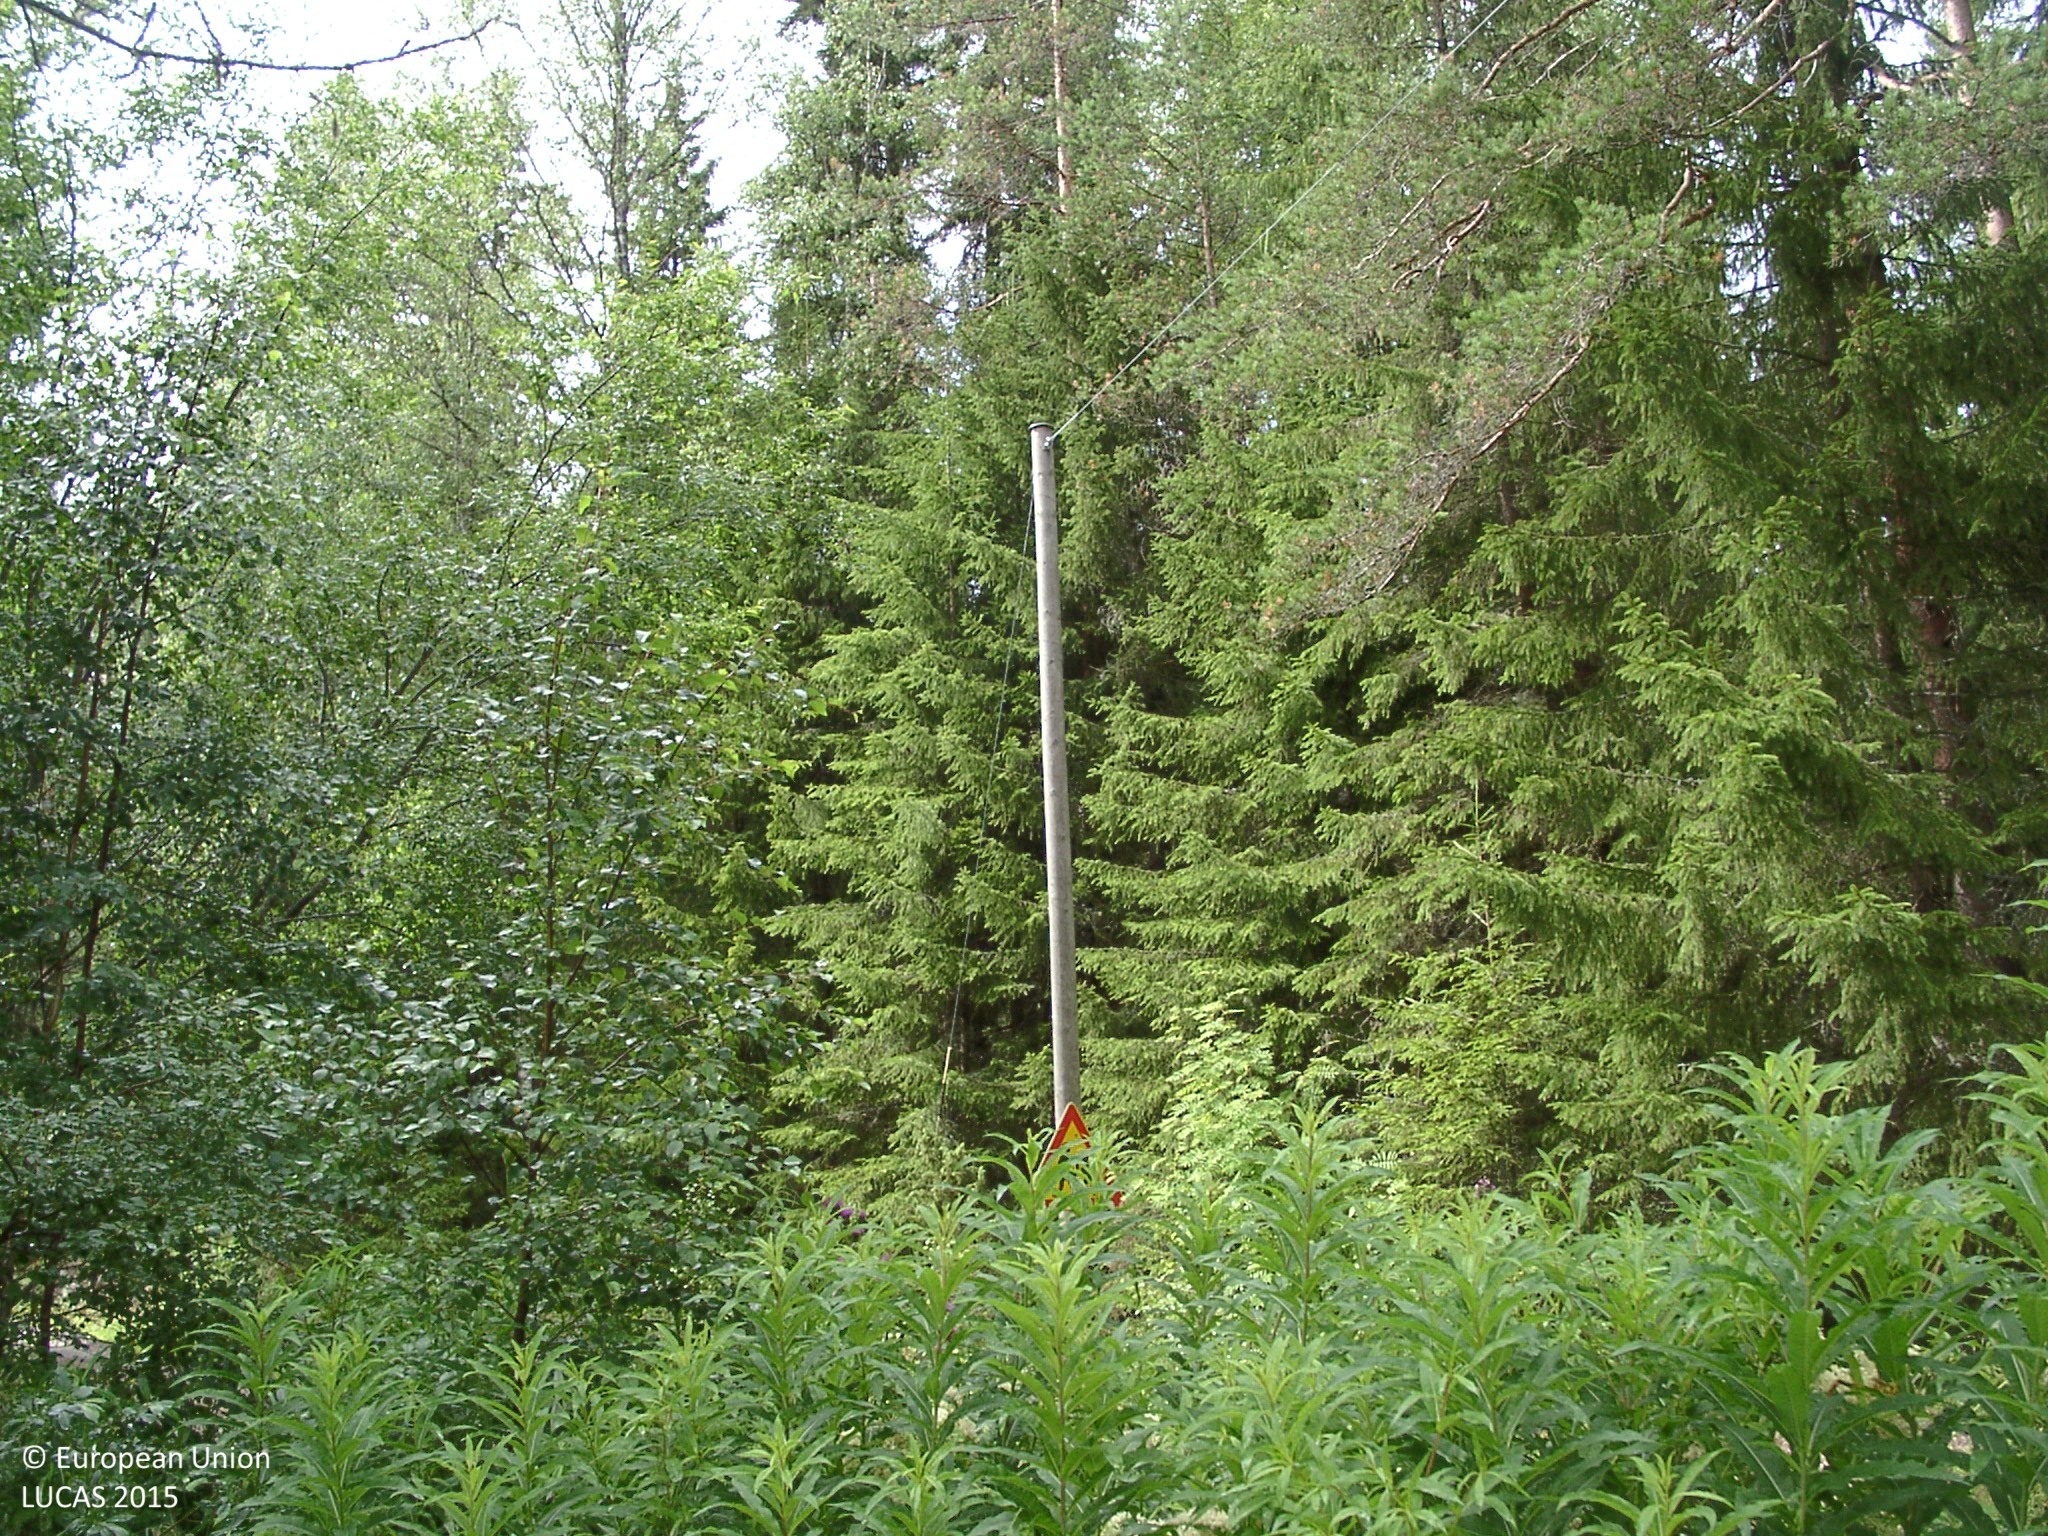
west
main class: Woodland
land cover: Broadleaved woodland
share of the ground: 25 - 50 %
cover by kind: broadleaved forest trees 35 %, herbaceous plants 30 %, coniferous forest trees 10 %, shrubs 10 %
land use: Residential
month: July
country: FI
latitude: 62.2845
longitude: 25.1192
